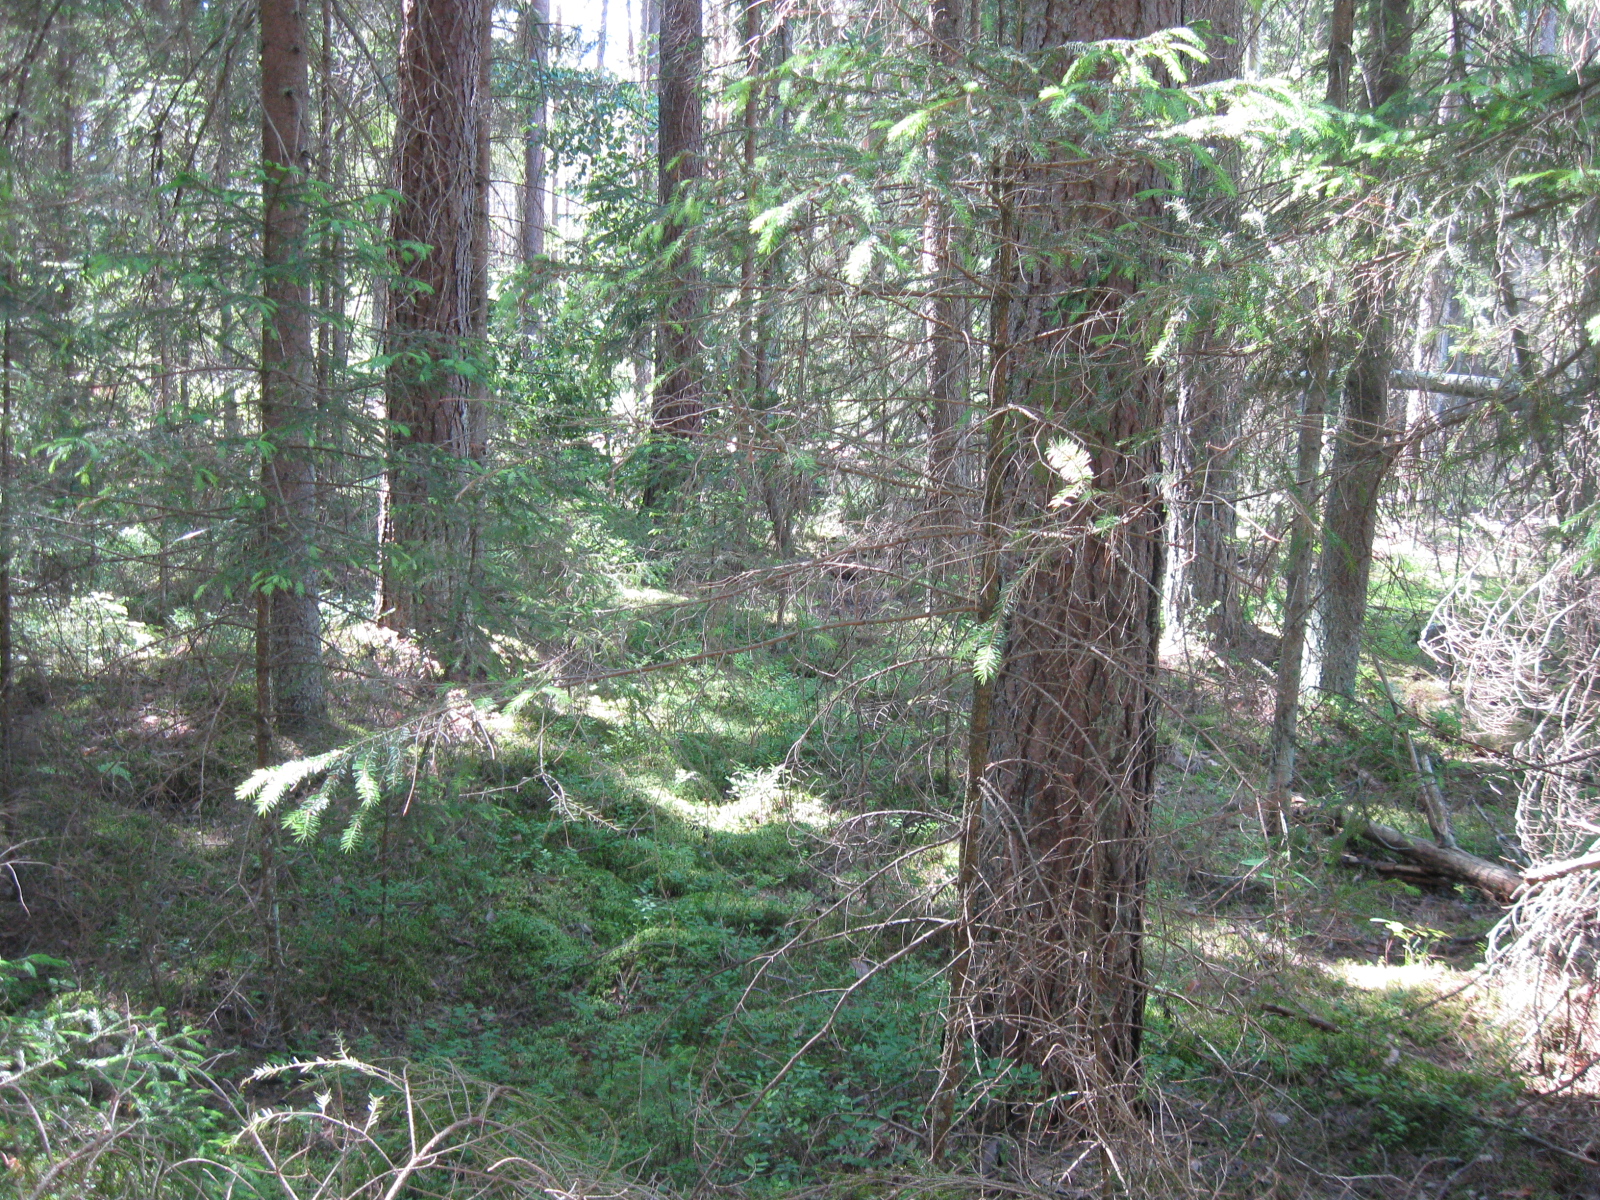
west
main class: Woodland
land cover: Other coniferous woodland
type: hemiboreal forest and nemoral coniferous forest and mixed broadleaved-coniferous forest
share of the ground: > 75 %
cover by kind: coniferous forest trees 95 %, lichens and mosses 5 %
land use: Forestry
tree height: > 5 m
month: June
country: LT
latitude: 53.9912
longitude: 24.1436
